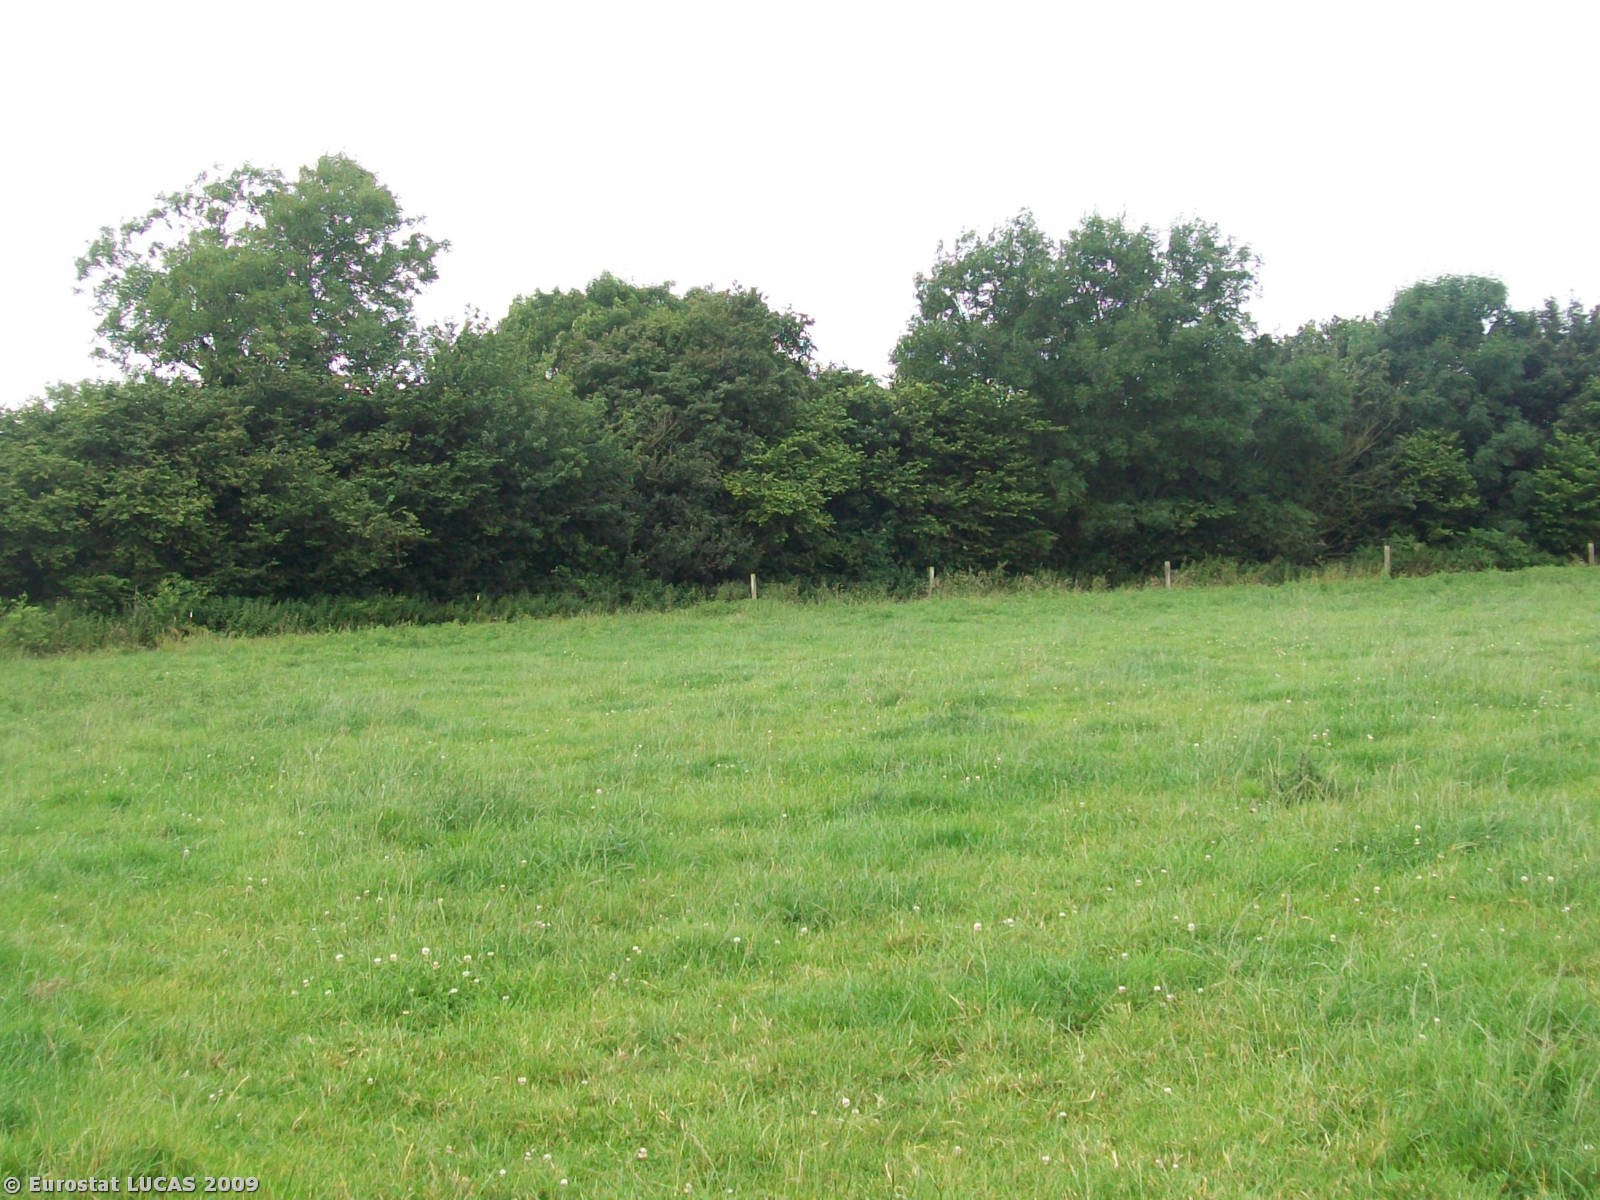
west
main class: Grassland
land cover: Grassland without tree/shrub cover
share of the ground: > 75 %
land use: Agriculture (excluding fallow land and kitchen gardens)
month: July
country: GB
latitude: 50.9252
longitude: -2.7175
